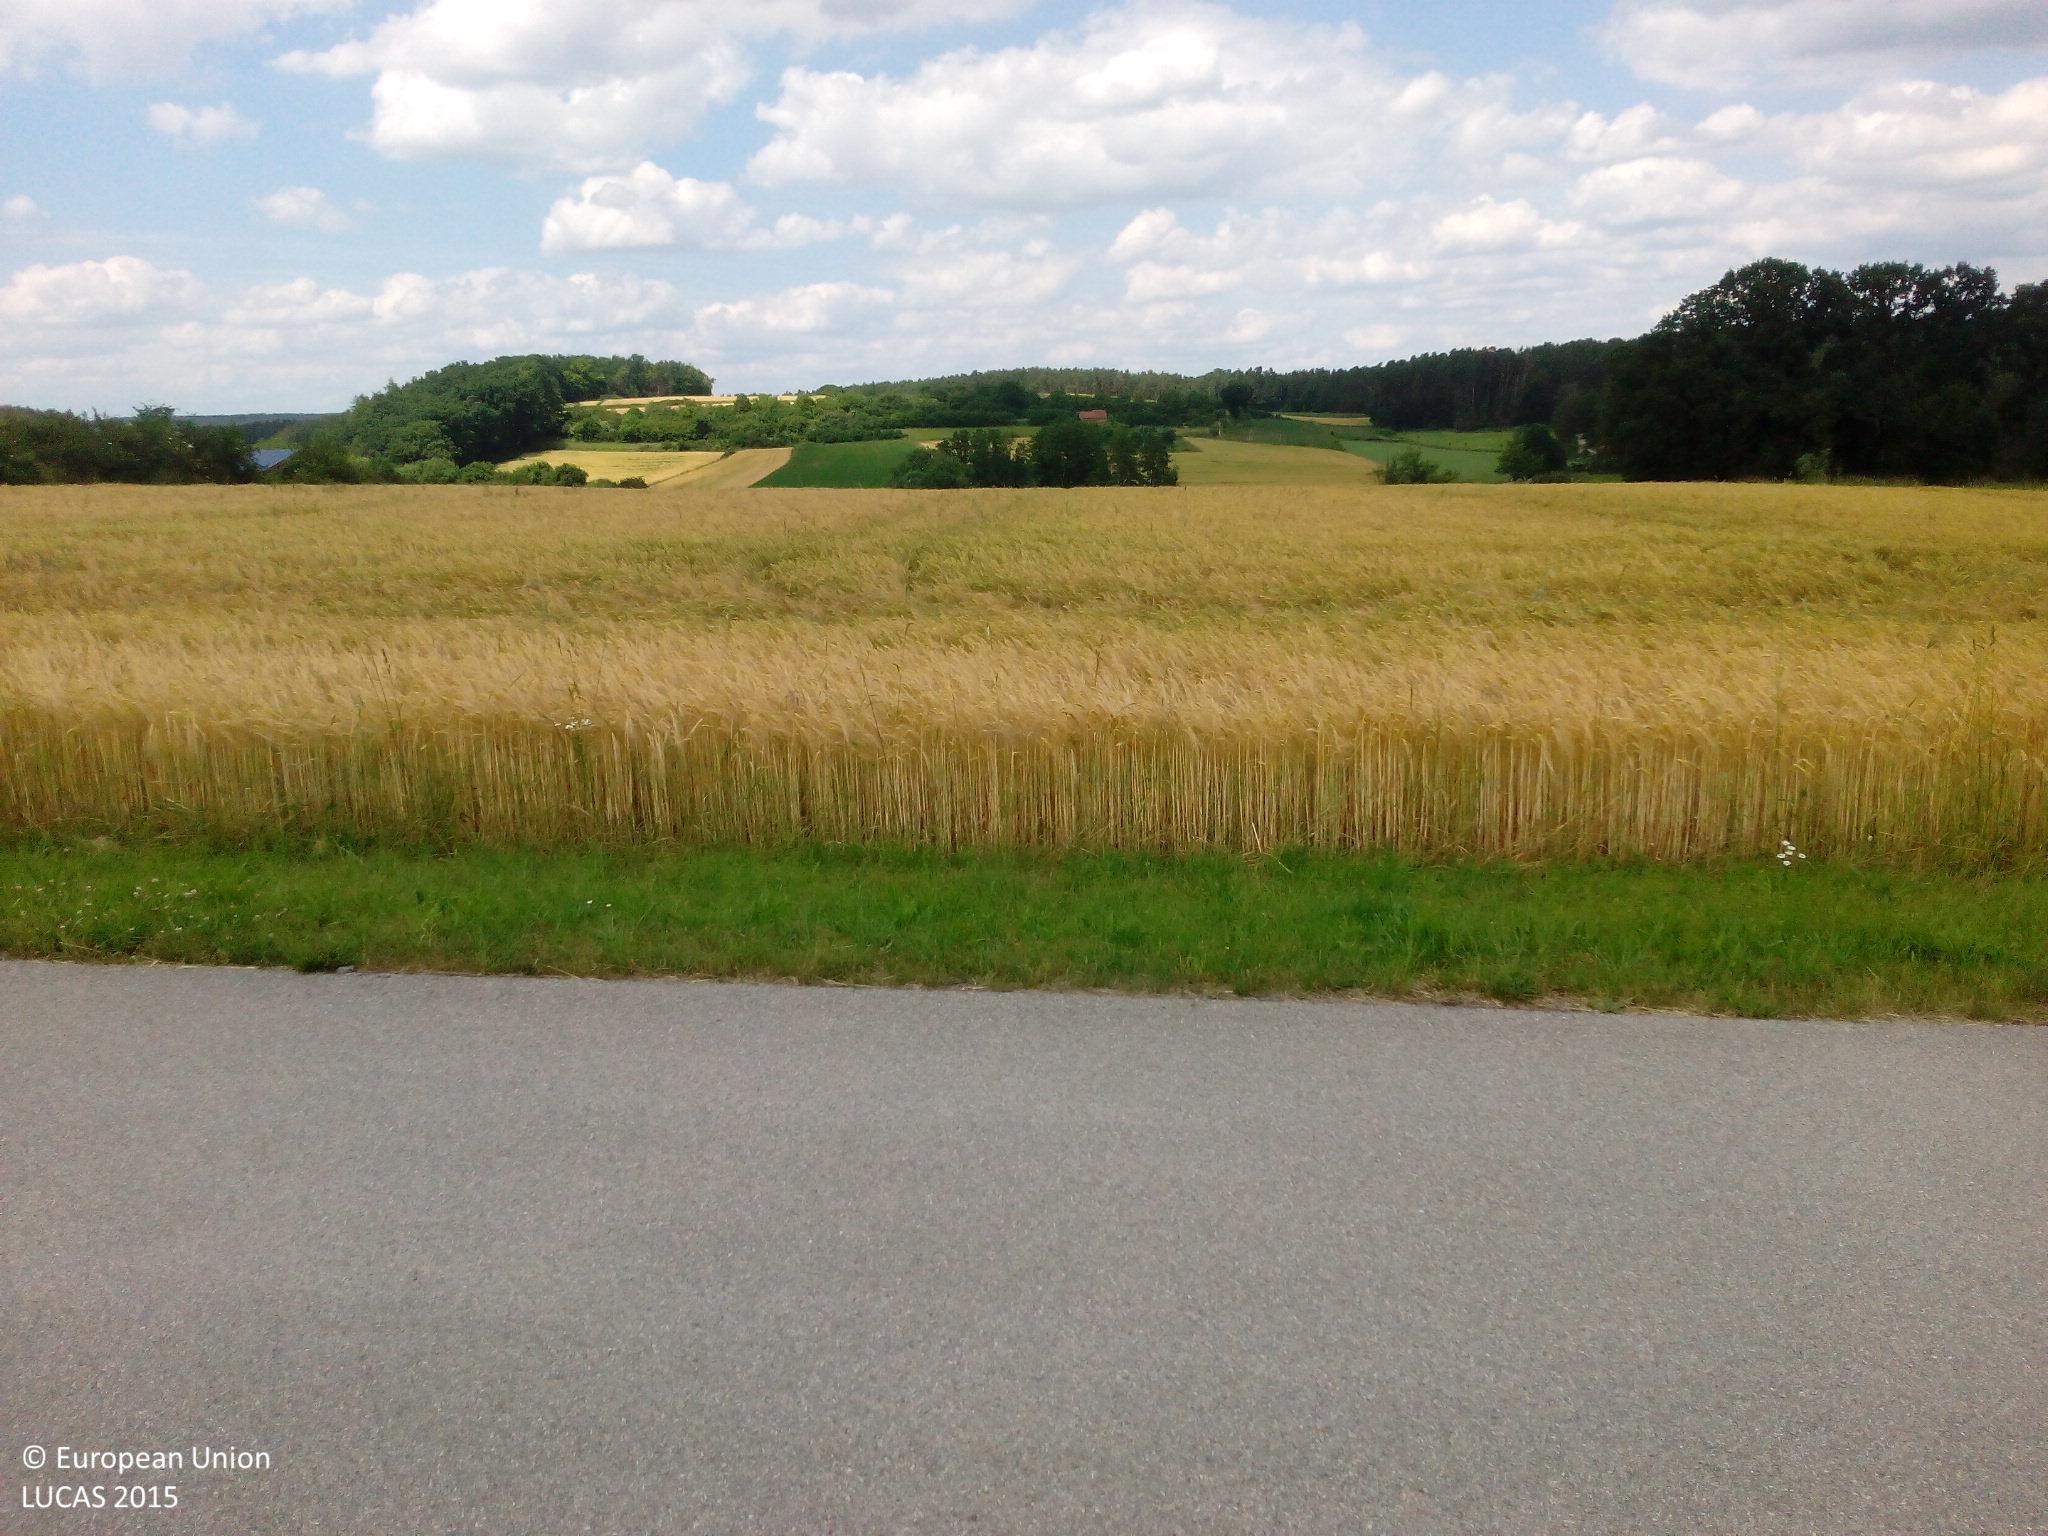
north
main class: Grassland
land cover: Grassland with sparse tree/shrub cover
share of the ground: > 75 %
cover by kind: herbaceous plants 95 %, broadleaved forest trees 5 %
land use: Road transport
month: June
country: DE
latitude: 49.1906
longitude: 11.0013
